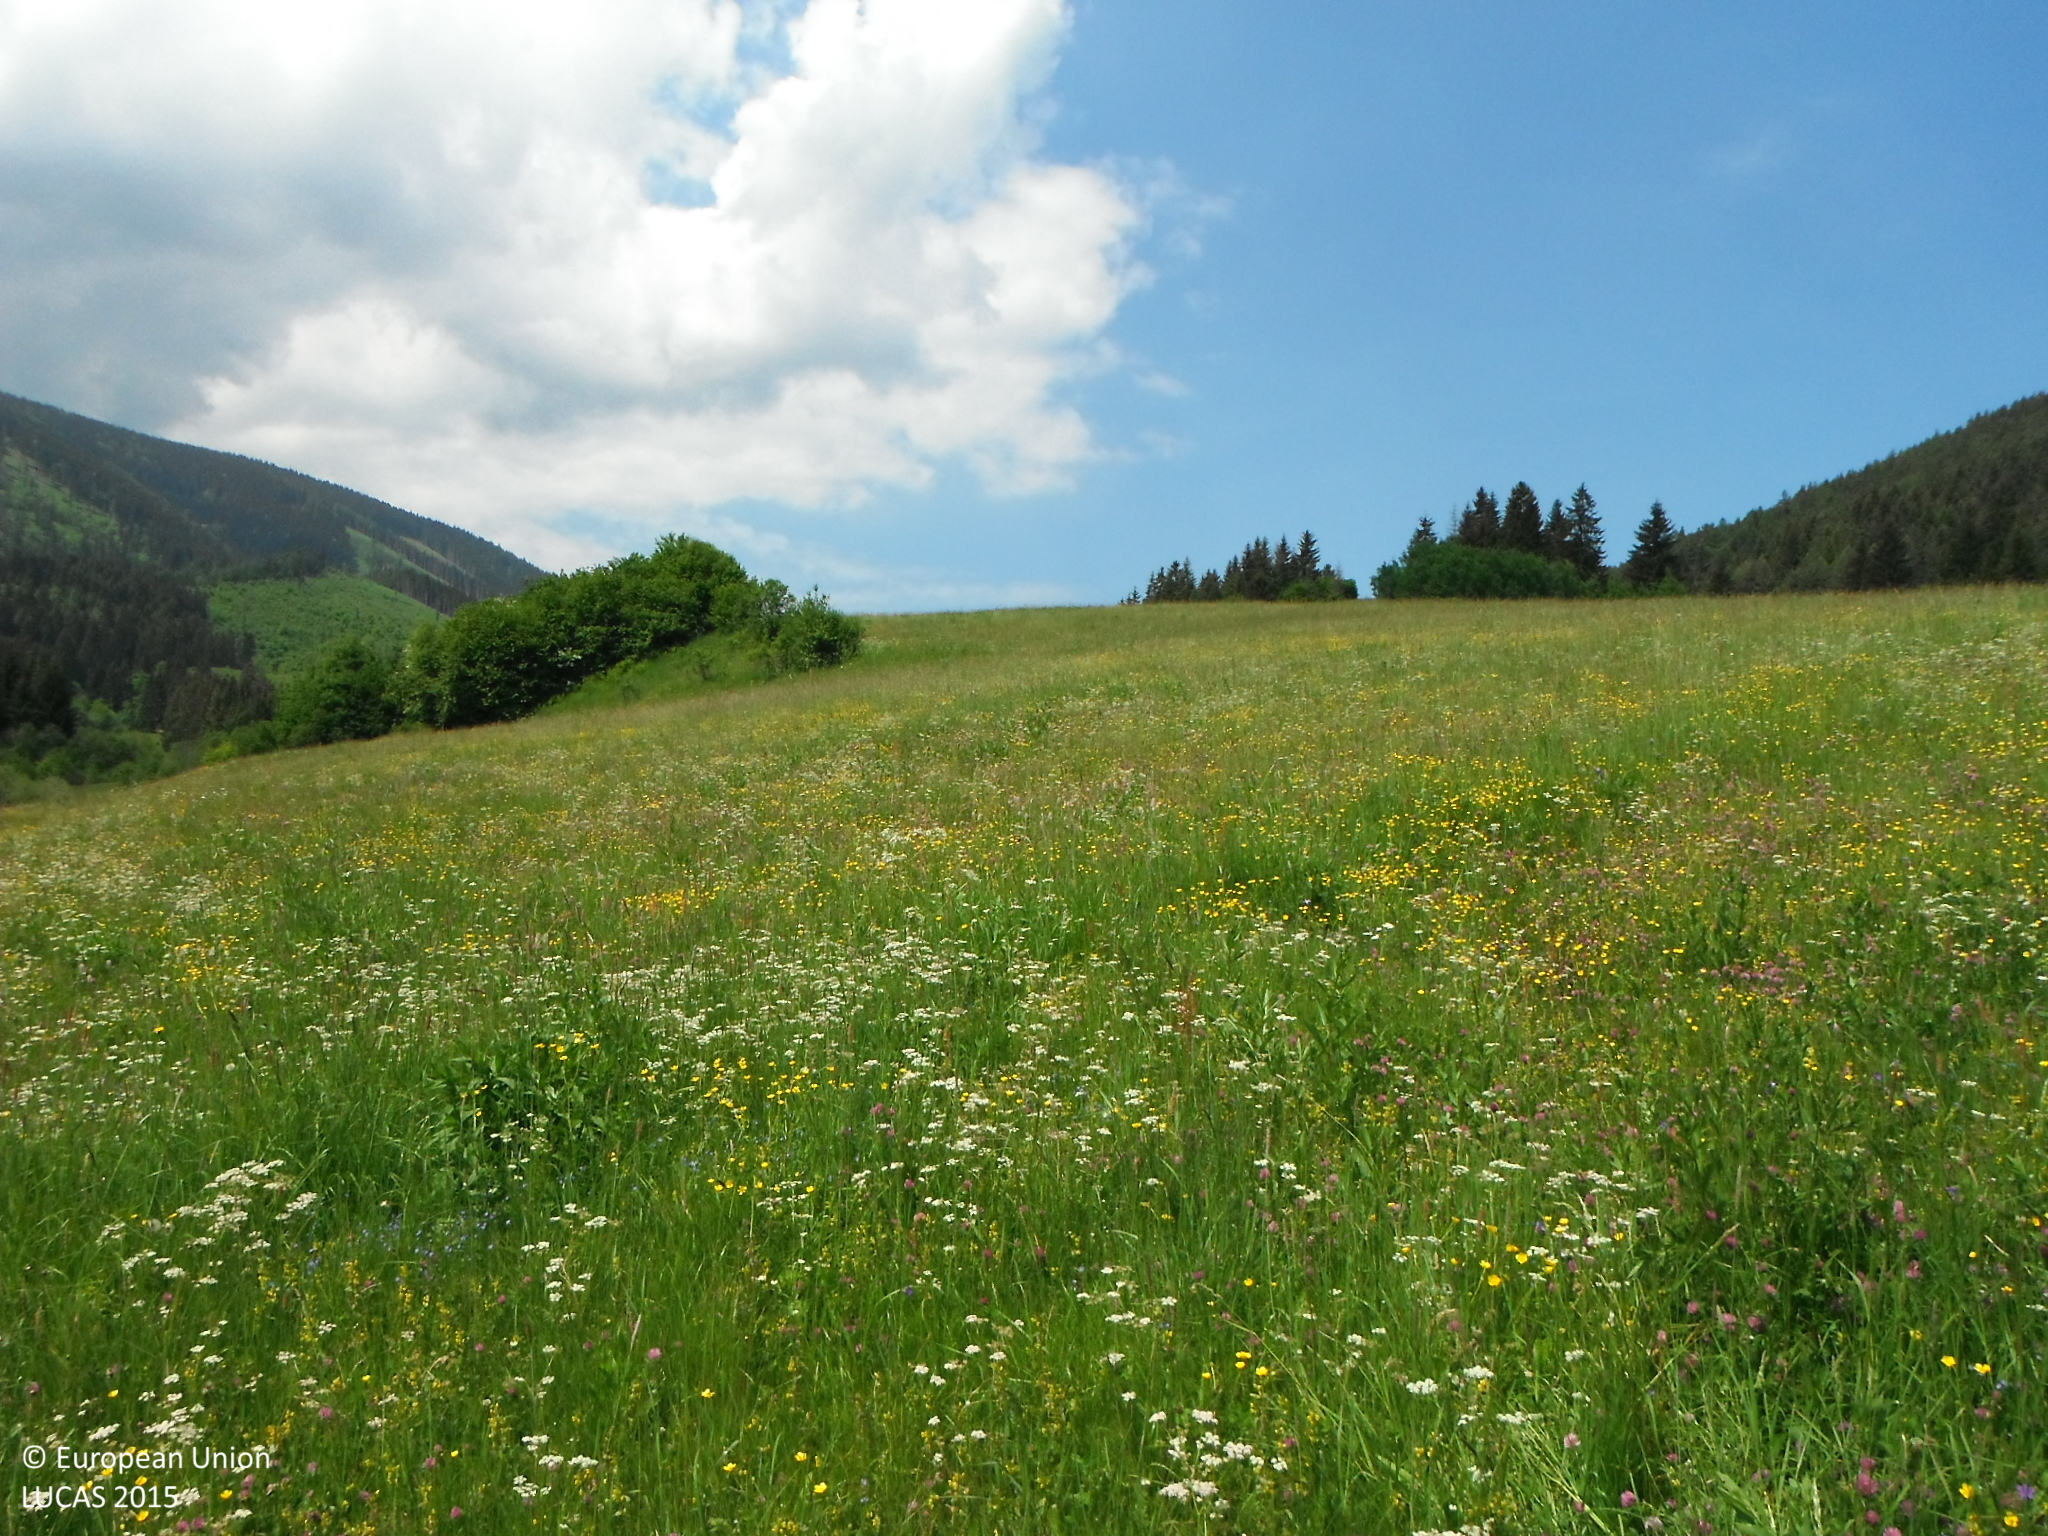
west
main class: Grassland
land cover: Grassland without tree/shrub cover
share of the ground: > 75 %
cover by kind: herbaceous plants 100 %
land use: Agriculture (excluding fallow land and kitchen gardens)
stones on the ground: > 50 %
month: June
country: SK
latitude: 49.0249
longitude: 19.7241
